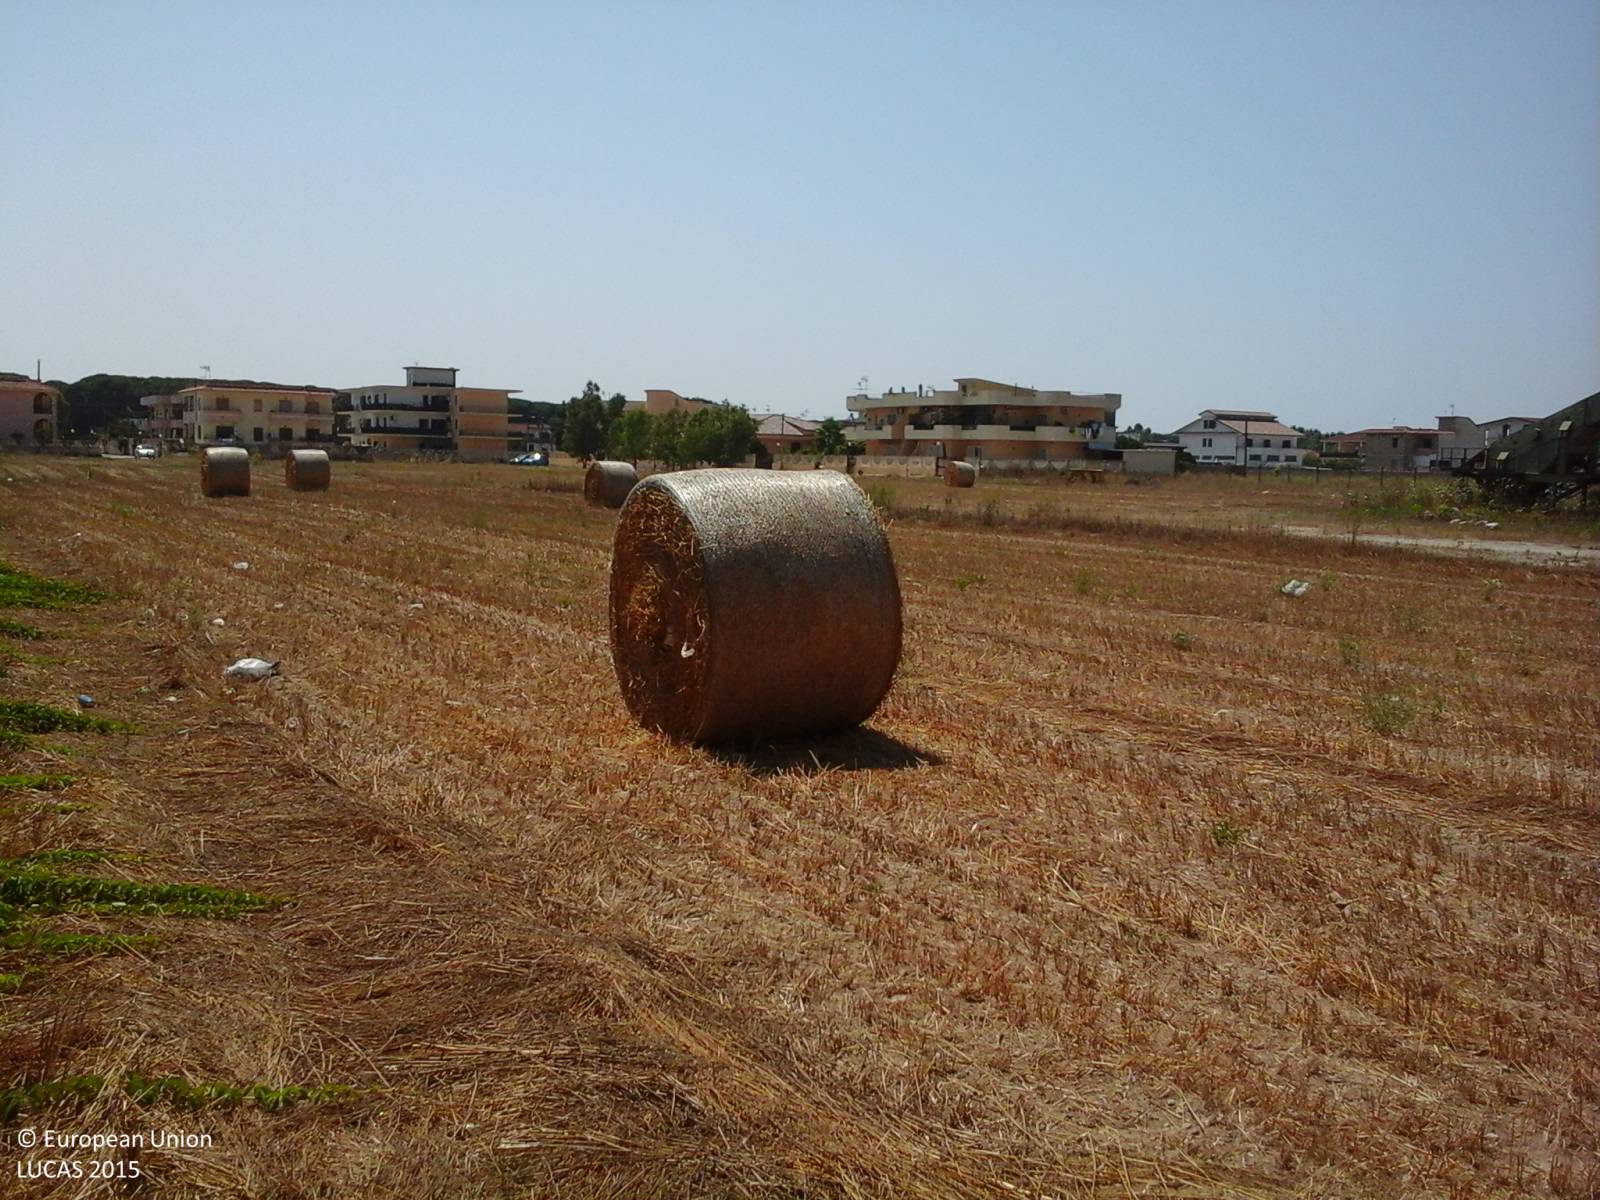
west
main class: Cropland
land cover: Oats
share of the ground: < 10 %
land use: Agriculture (excluding fallow land and kitchen gardens)
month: July
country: IT
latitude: 40.9832
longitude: 13.9889
